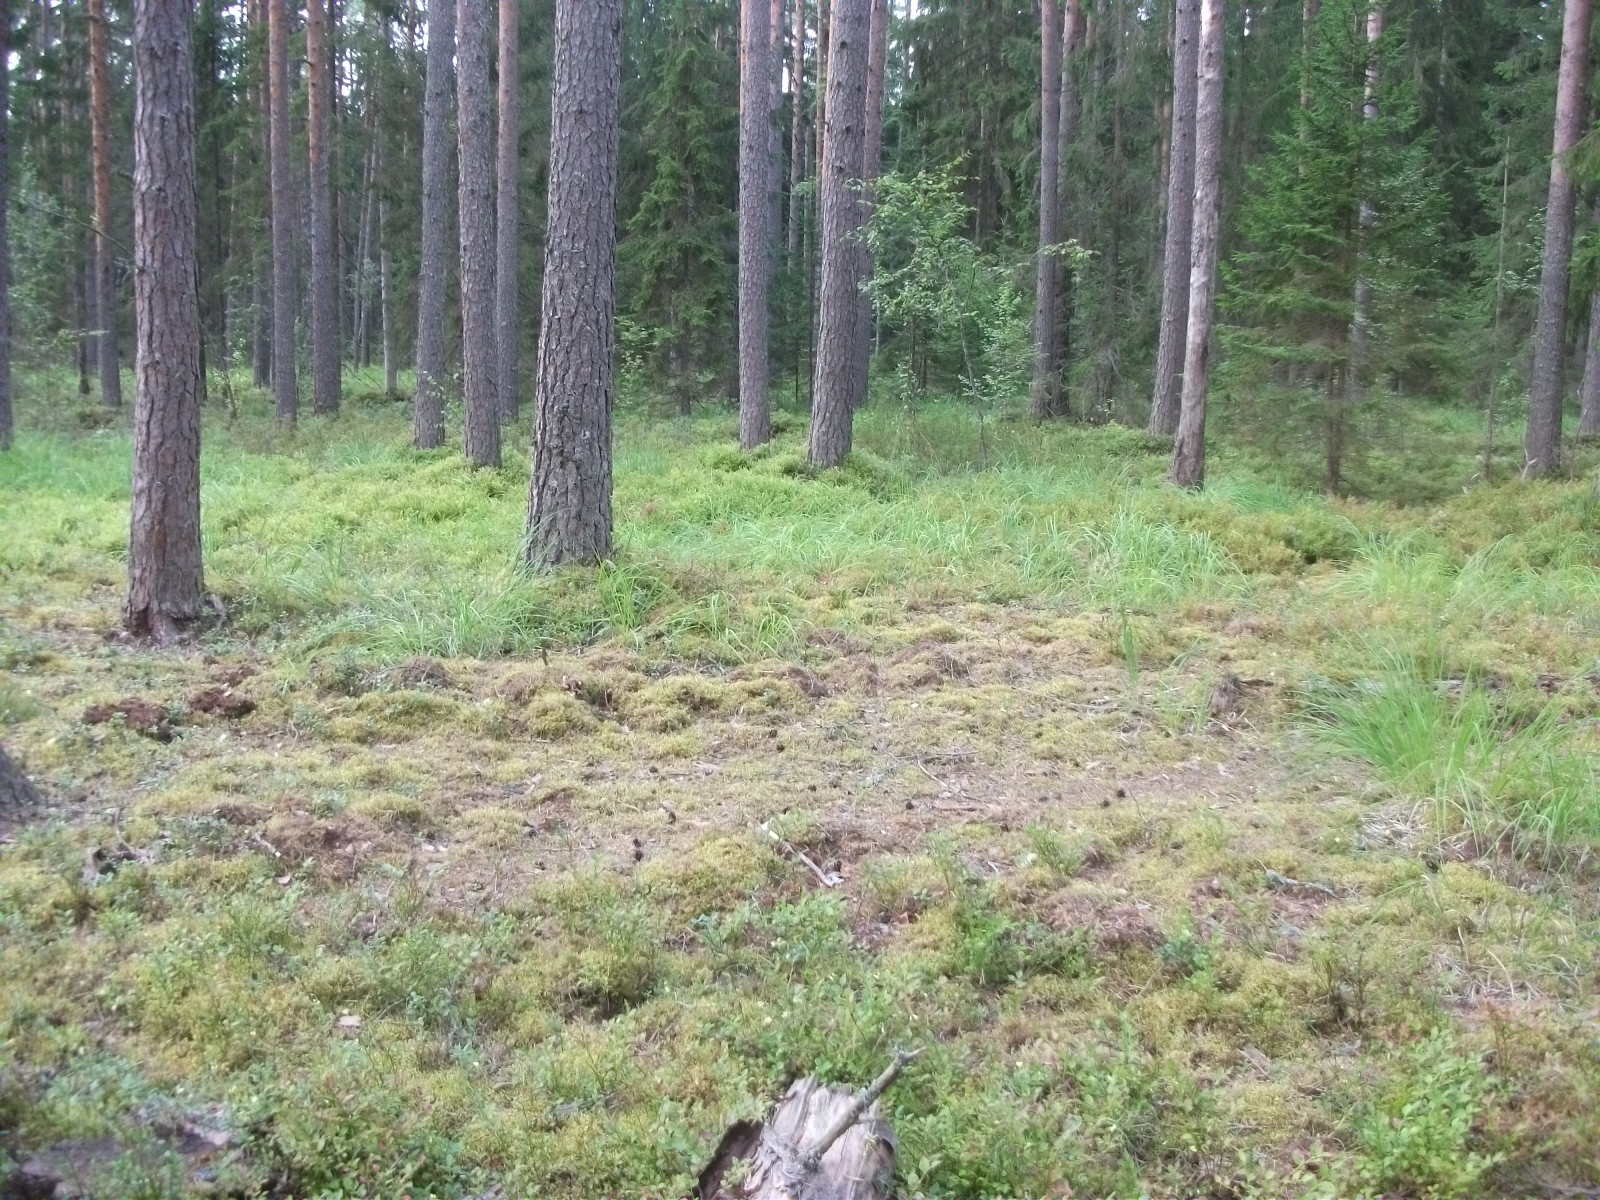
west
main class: Woodland
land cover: Other coniferous woodland
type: hemiboreal forest and nemoral coniferous forest and mixed broadleaved-coniferous forest
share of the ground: 50 - 75 %
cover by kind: coniferous forest trees 70 %, lichens and mosses 20 %, herbaceous plants 10 %
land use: Forestry
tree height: > 5 m
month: August
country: LV
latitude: 56.8533
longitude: 26.5287
